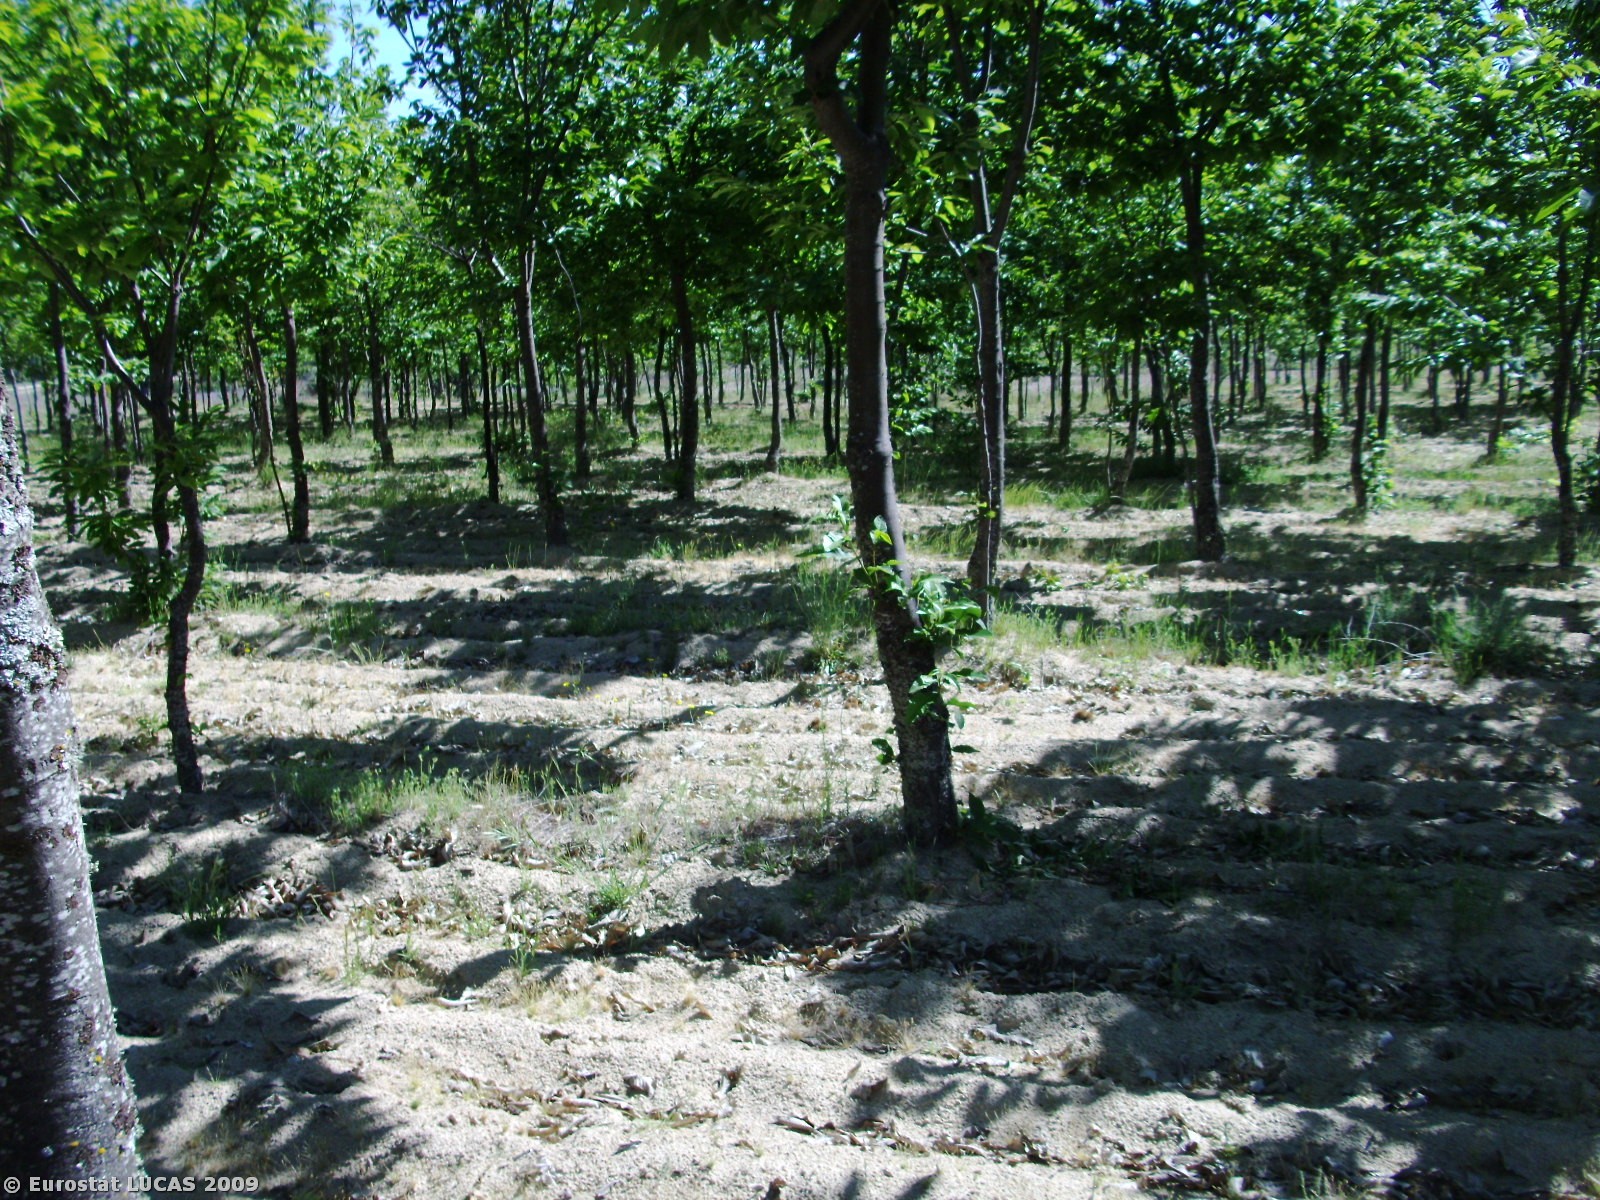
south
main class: Woodland
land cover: Broadleaved woodland
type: mesophytic deciduous forest
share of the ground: 50 - 75 %
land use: Forestry
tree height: > 5 m
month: May
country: PT
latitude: 40.8527
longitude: -7.3244
